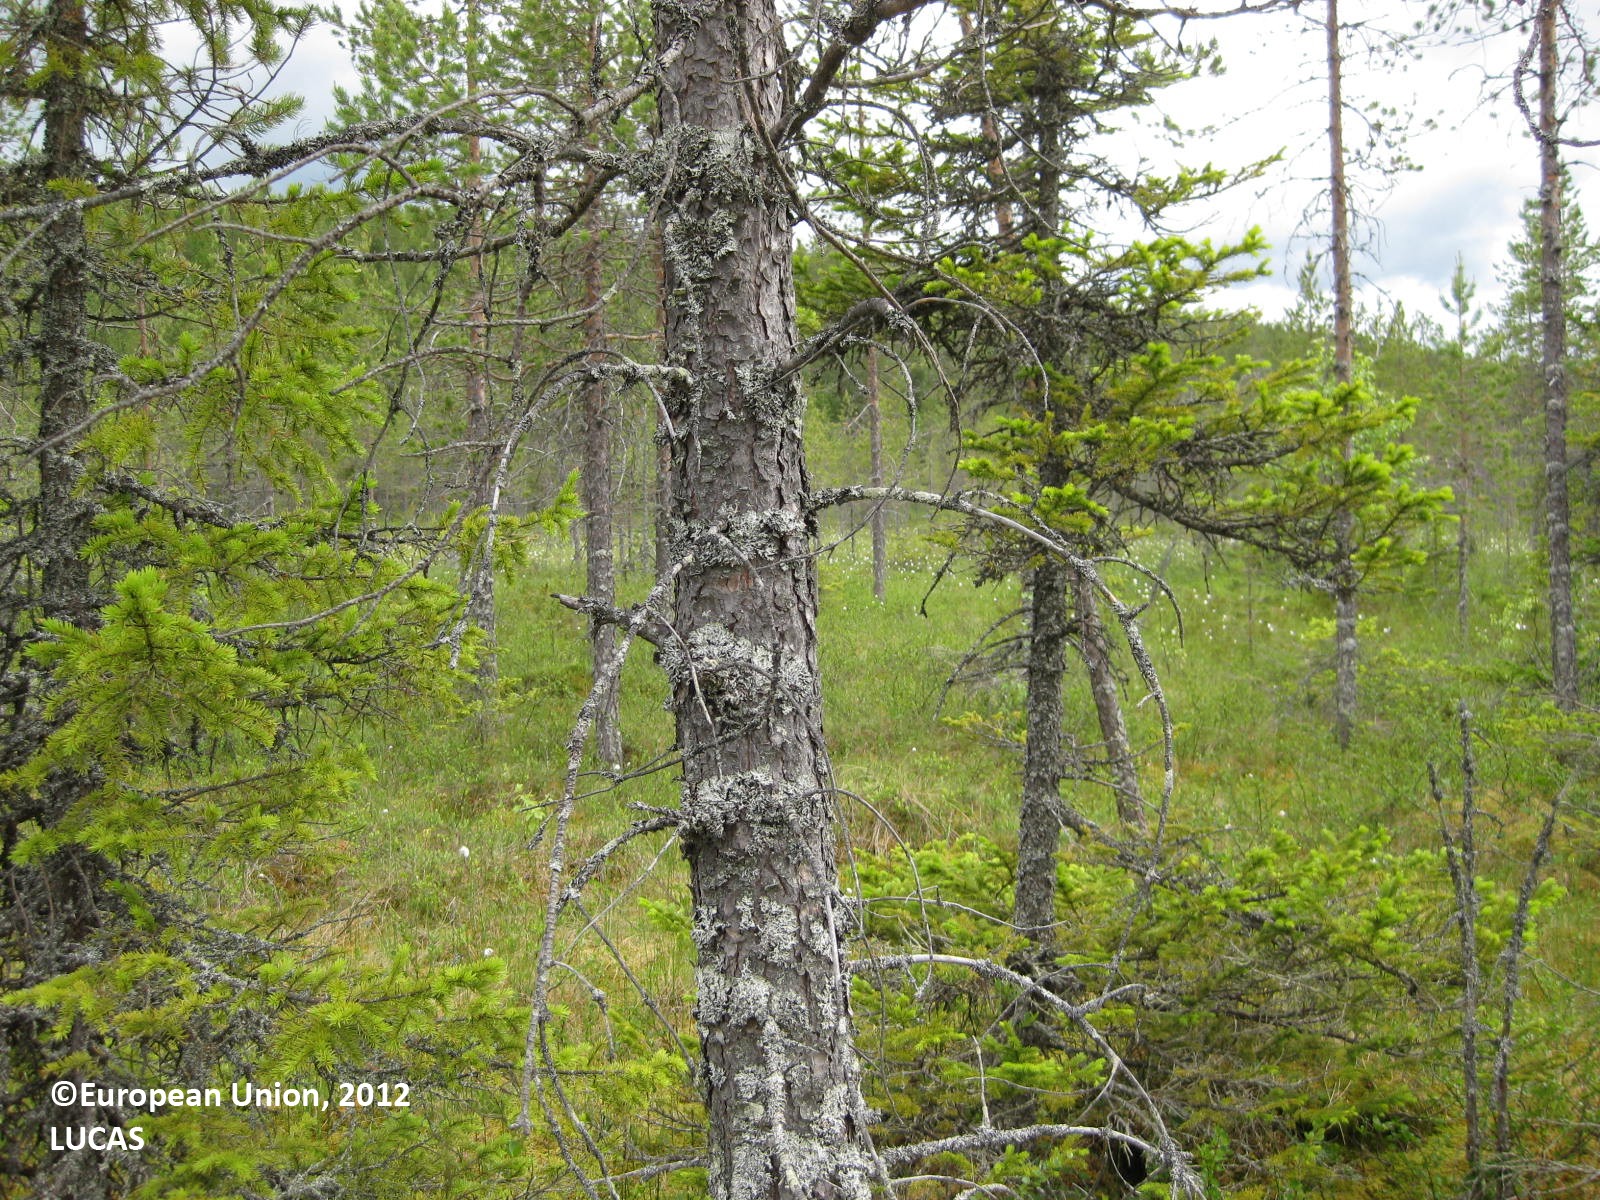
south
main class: Woodland
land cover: Pine dominated coniferous woodland
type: boreal forest
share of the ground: 50 - 75 %
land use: Semi-natural and natural areas not in use
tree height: > 5 m
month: June
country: FI
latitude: 65.3224
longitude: 28.2512
